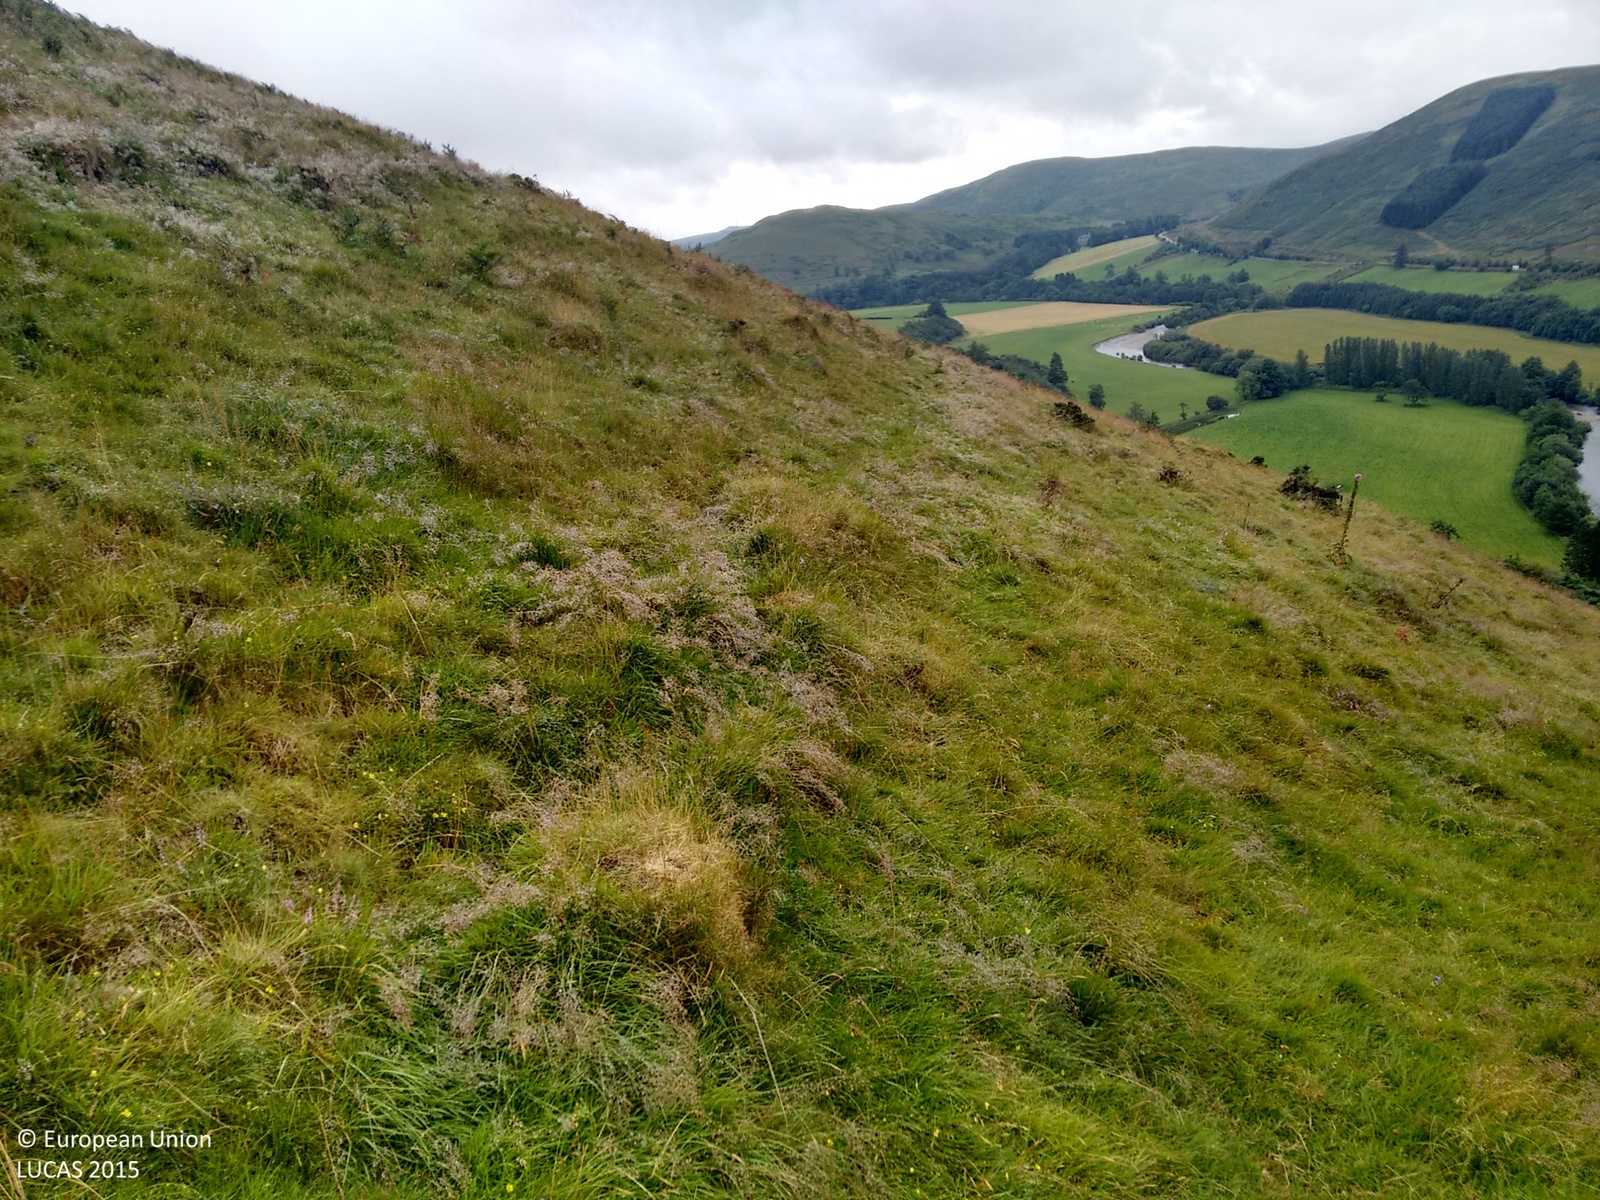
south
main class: Grassland
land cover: Grassland with sparse tree/shrub cover
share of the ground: > 75 %
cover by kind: herbaceous plants 90 %, broadleaved forest trees 5 %, shrubs 5 %
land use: Semi-natural and natural areas not in use
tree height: < 5 m
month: August
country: GB
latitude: 55.1914
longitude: -3.0302
